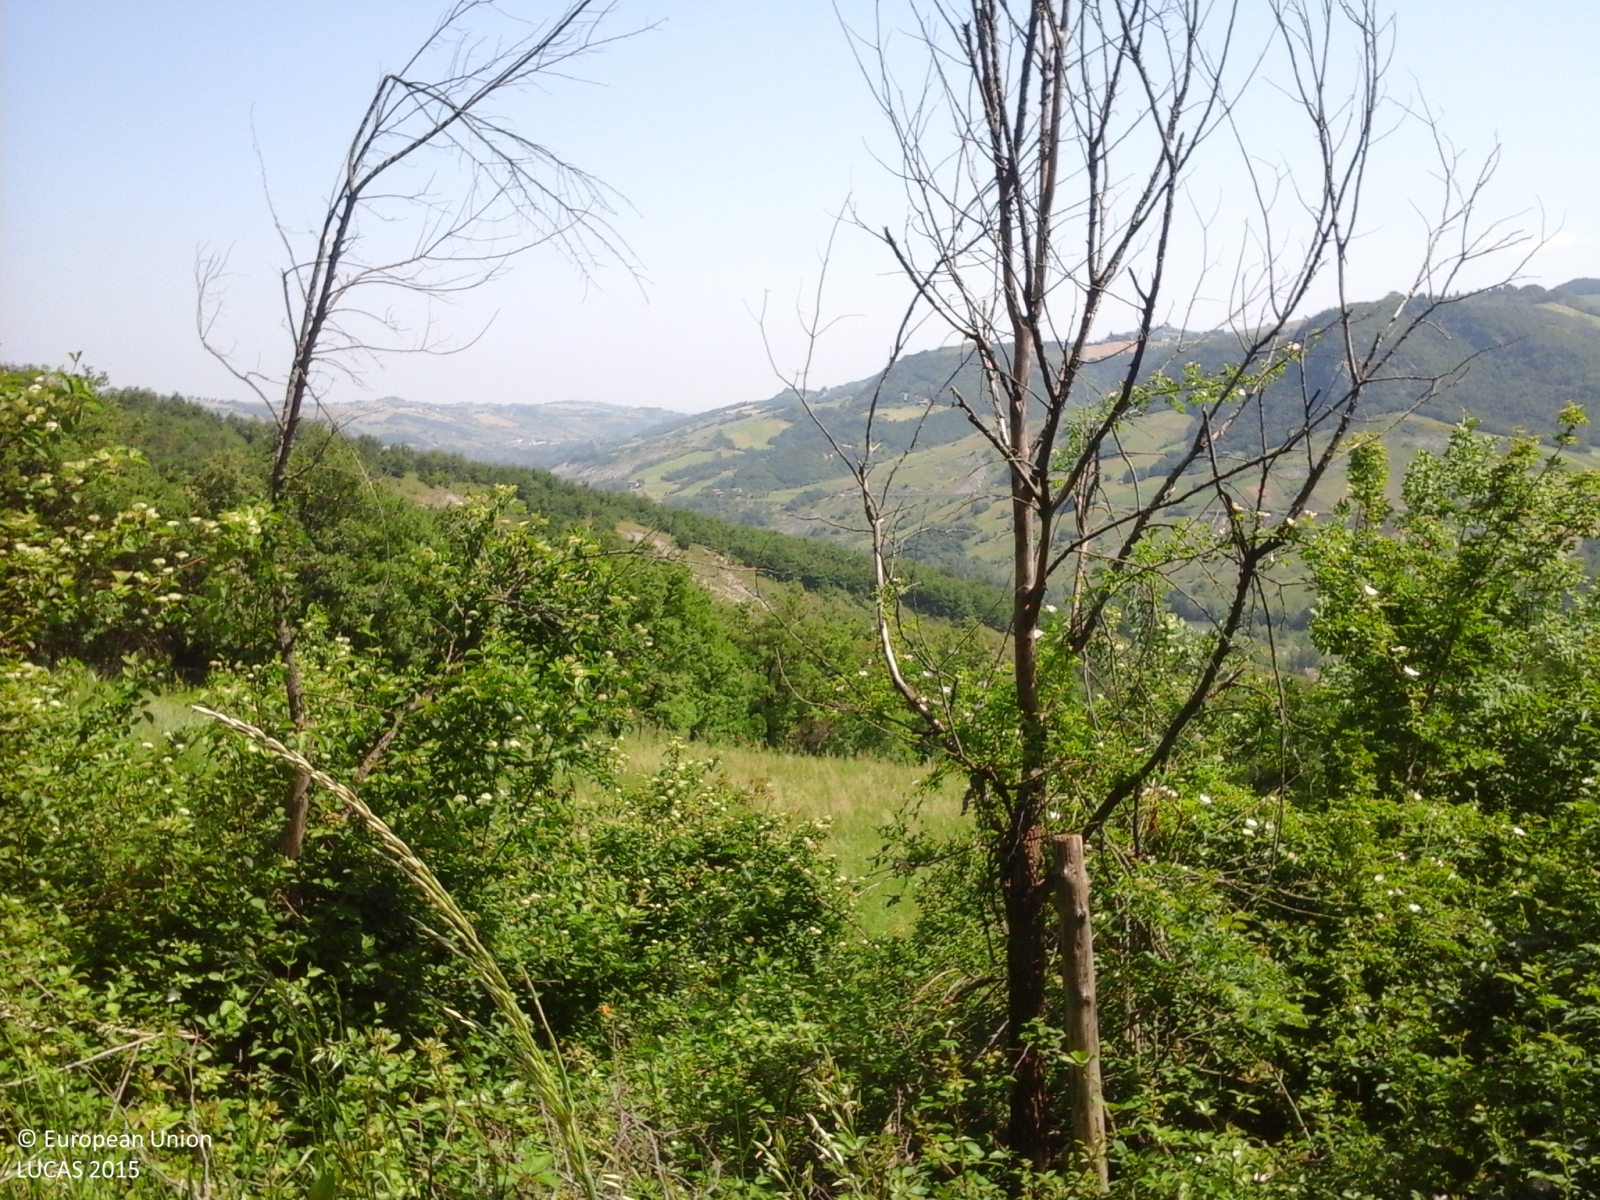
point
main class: Grassland
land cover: Grassland without tree/shrub cover
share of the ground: > 75 %
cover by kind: herbaceous plants 100 %
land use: Agriculture (excluding fallow land and kitchen gardens)
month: May
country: IT
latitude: 44.4006
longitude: 10.9145
